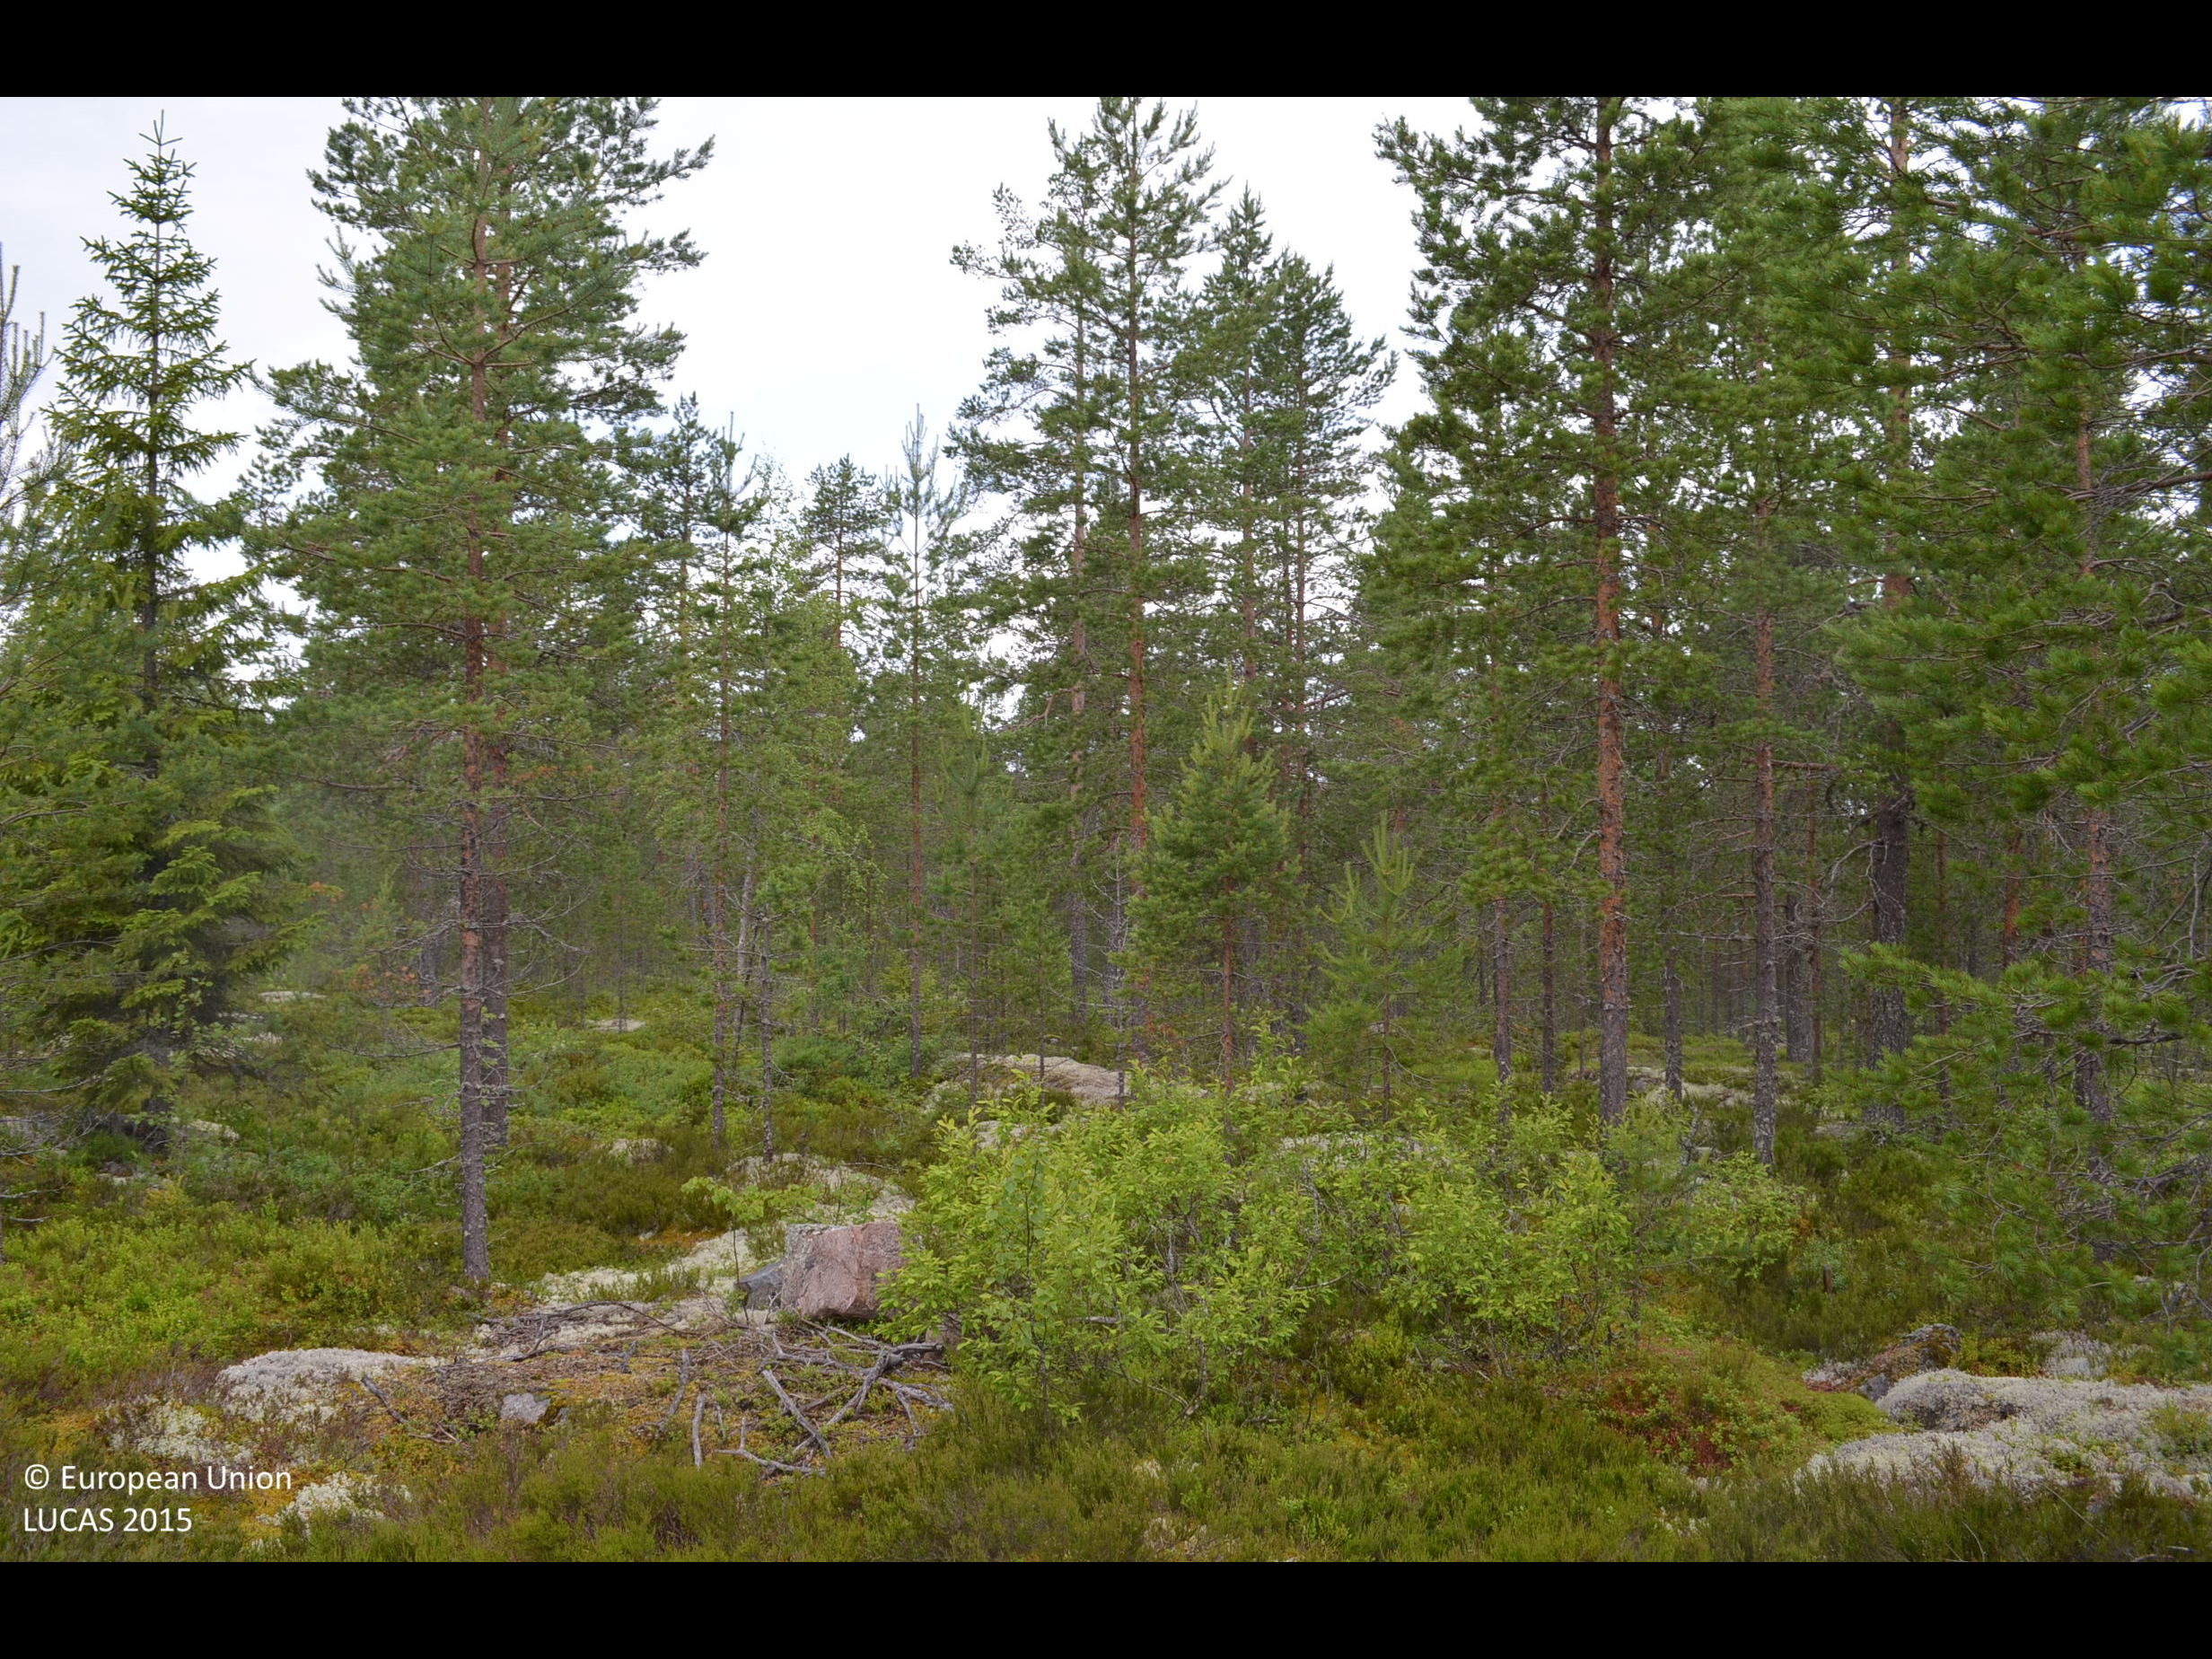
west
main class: Woodland
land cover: Pine dominated coniferous woodland
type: boreal forest
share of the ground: 25 - 50 %
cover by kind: coniferous forest trees 45 %, shrubs 35 %, lichens and mosses 15 %, consolidated bare surface 5 %
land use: Forestry
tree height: < 5 m
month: July
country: FI
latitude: 62.2794
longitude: 23.6614
